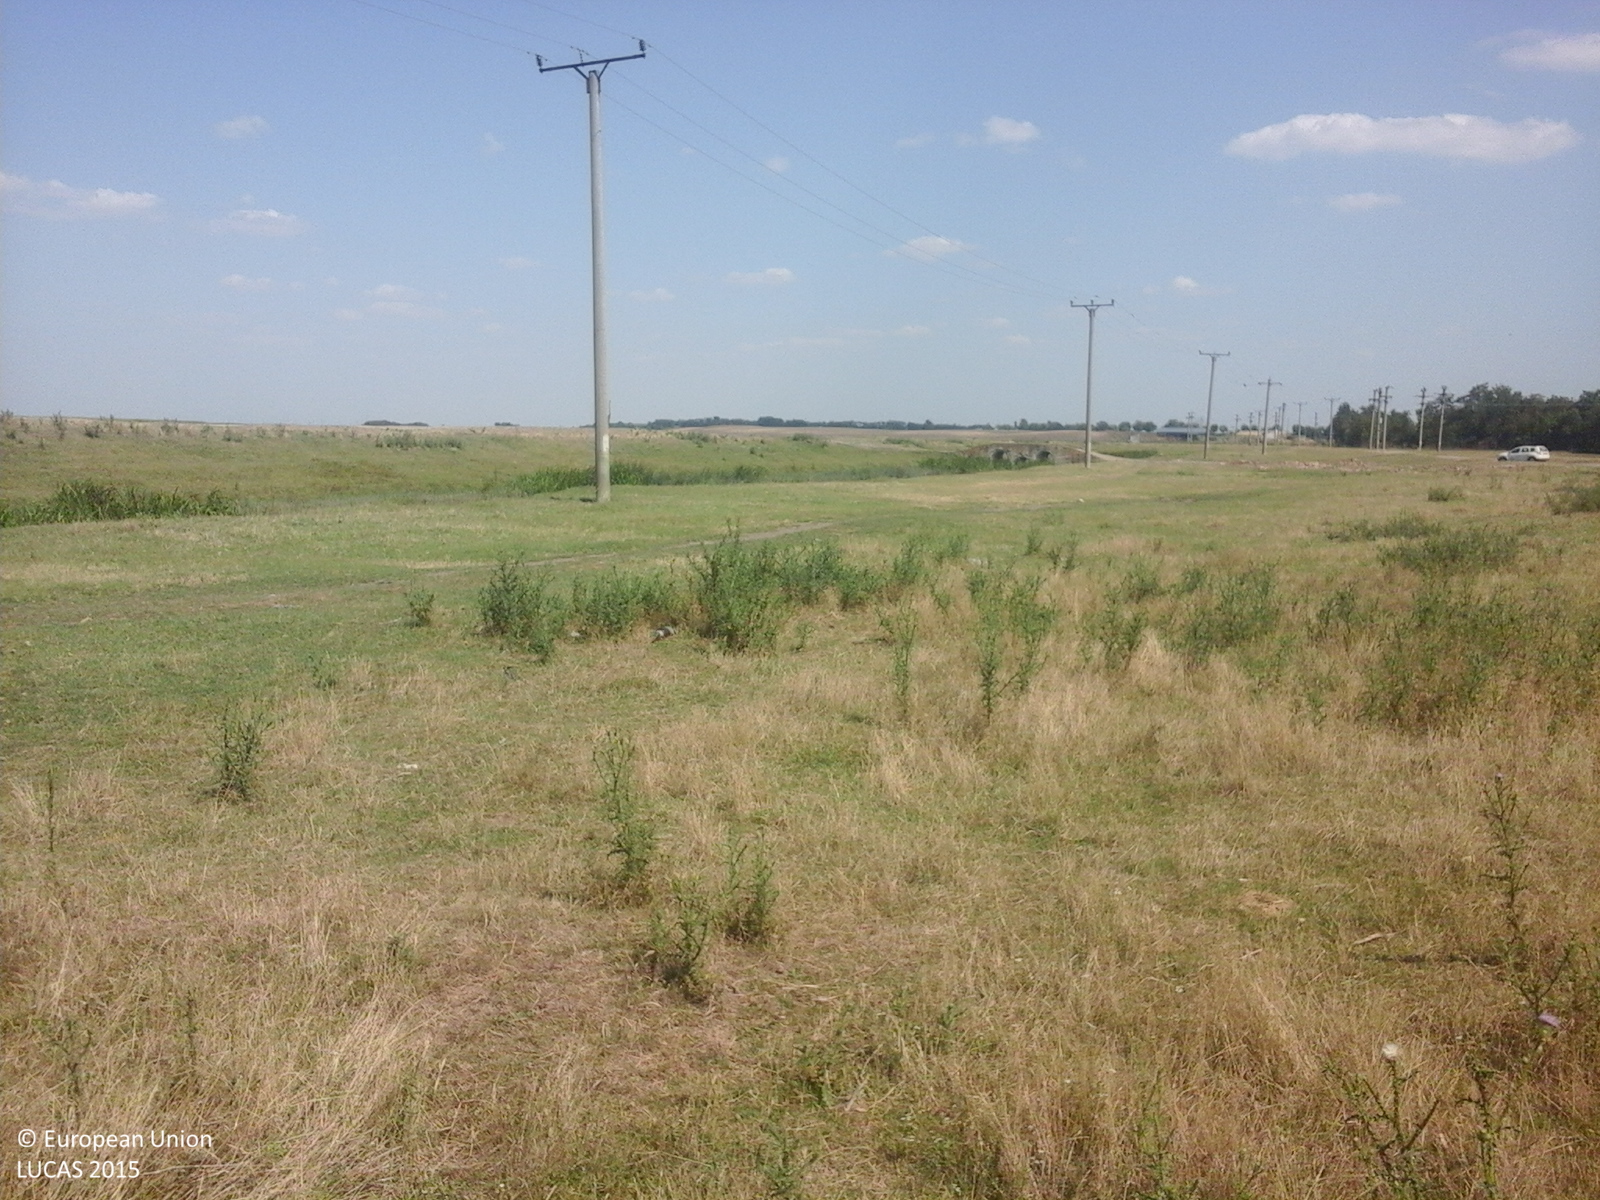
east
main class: Grassland
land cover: Spontaneously vegetated surfaces
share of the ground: > 75 %
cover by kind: herbaceous plants 100 %
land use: Agriculture (excluding fallow land and kitchen gardens)
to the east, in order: Spontaneously vegetated surfaces; Tracks; Grassland without tree/shrub cover; Electric lines; Spontaneously vegetated surfaces; Inland fresh running water; Spontaneously vegetated surfaces; Inland fresh running water; Spontaneously vegetated surfaces; Tracks; Grassland without tree/shrub cover
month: July
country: RO
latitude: 44.9999
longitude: 26.8630
